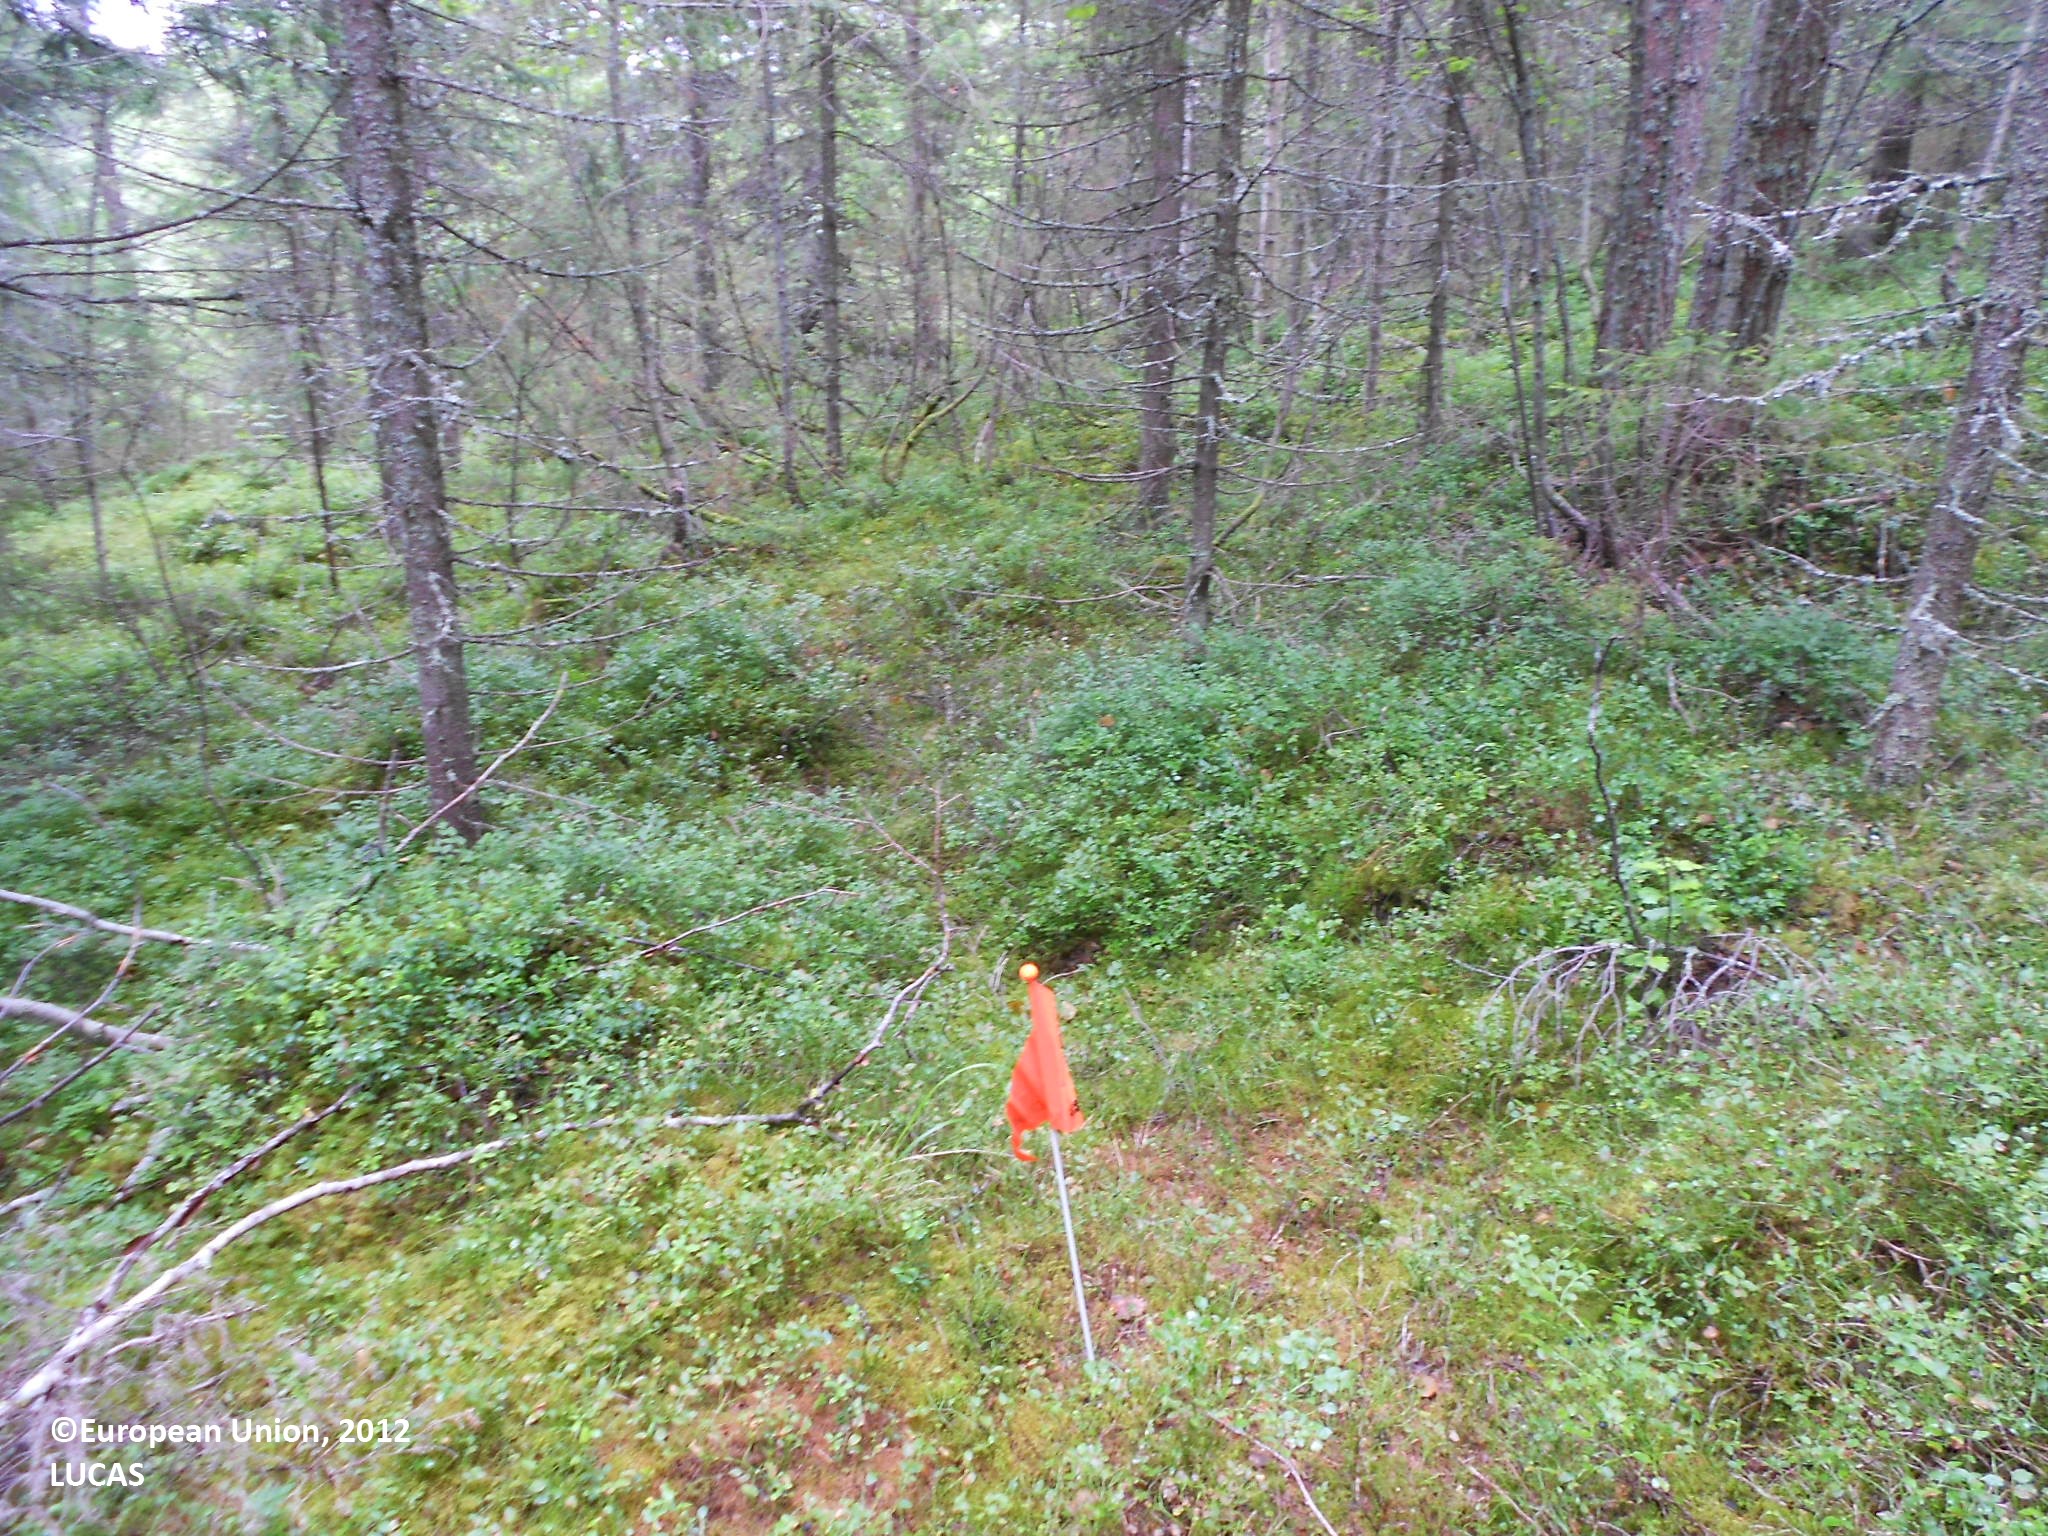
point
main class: Woodland
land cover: Spruce dominated coniferous woodland
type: boreal forest
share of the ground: > 75 %
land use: Forestry
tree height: > 5 m
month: August
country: FI
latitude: 63.4656
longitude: 28.9247
